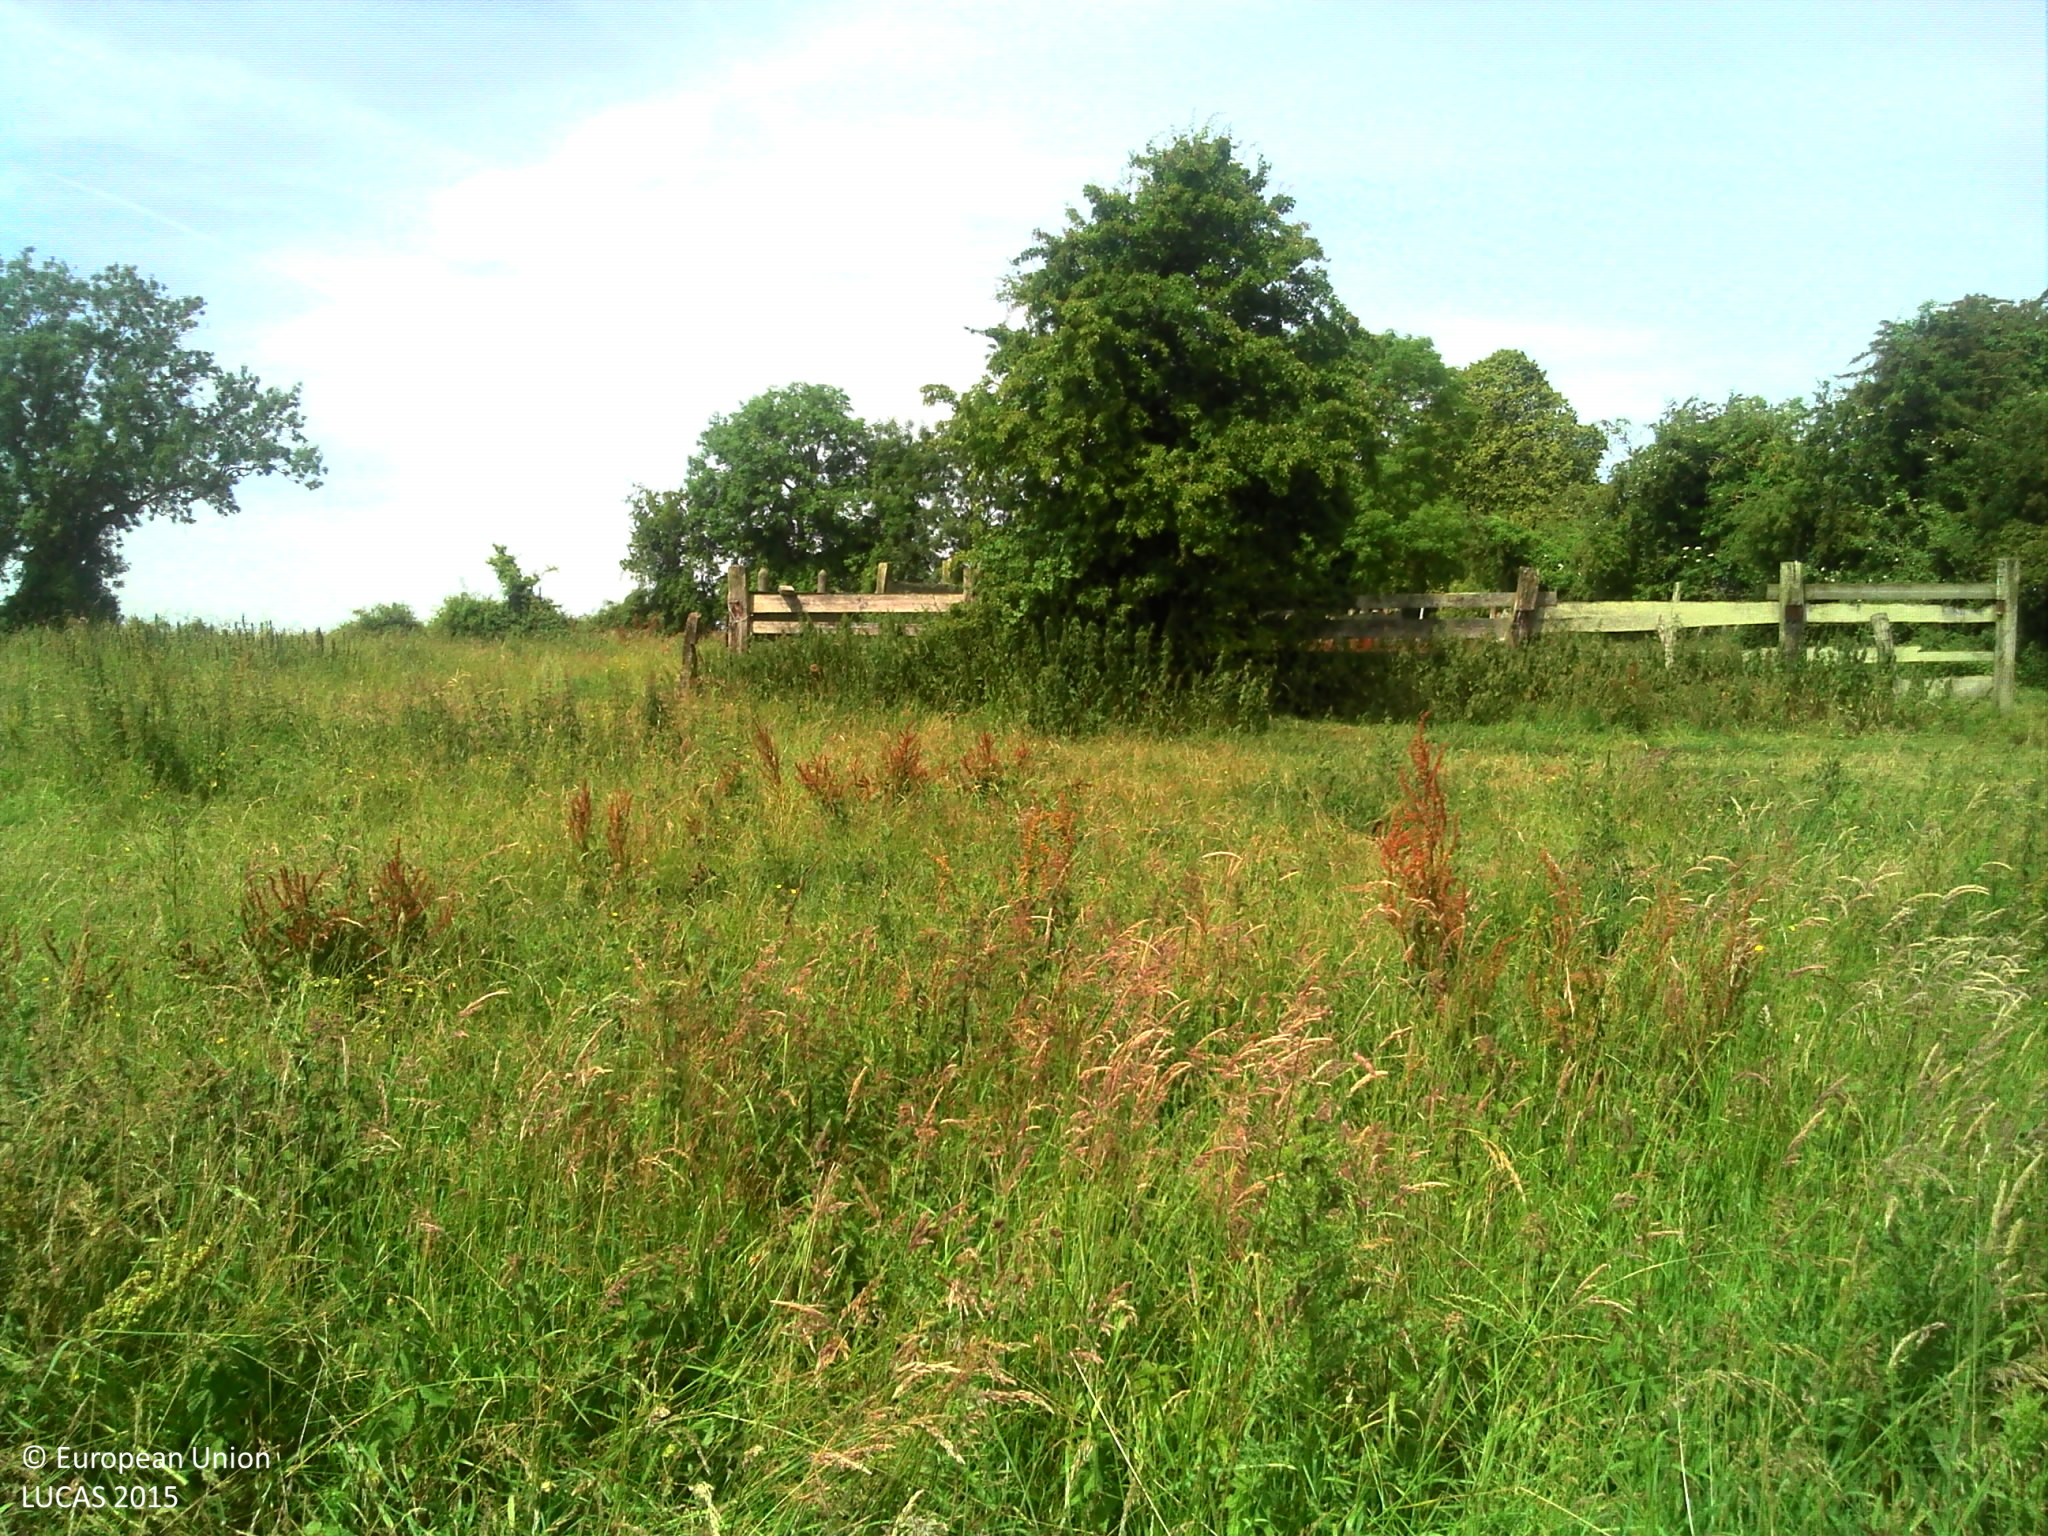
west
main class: Grassland
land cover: Grassland without tree/shrub cover
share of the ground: > 75 %
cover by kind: herbaceous plants 100 %
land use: Agriculture (excluding fallow land and kitchen gardens)
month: June
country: FR
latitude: 48.8161
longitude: -0.2331
